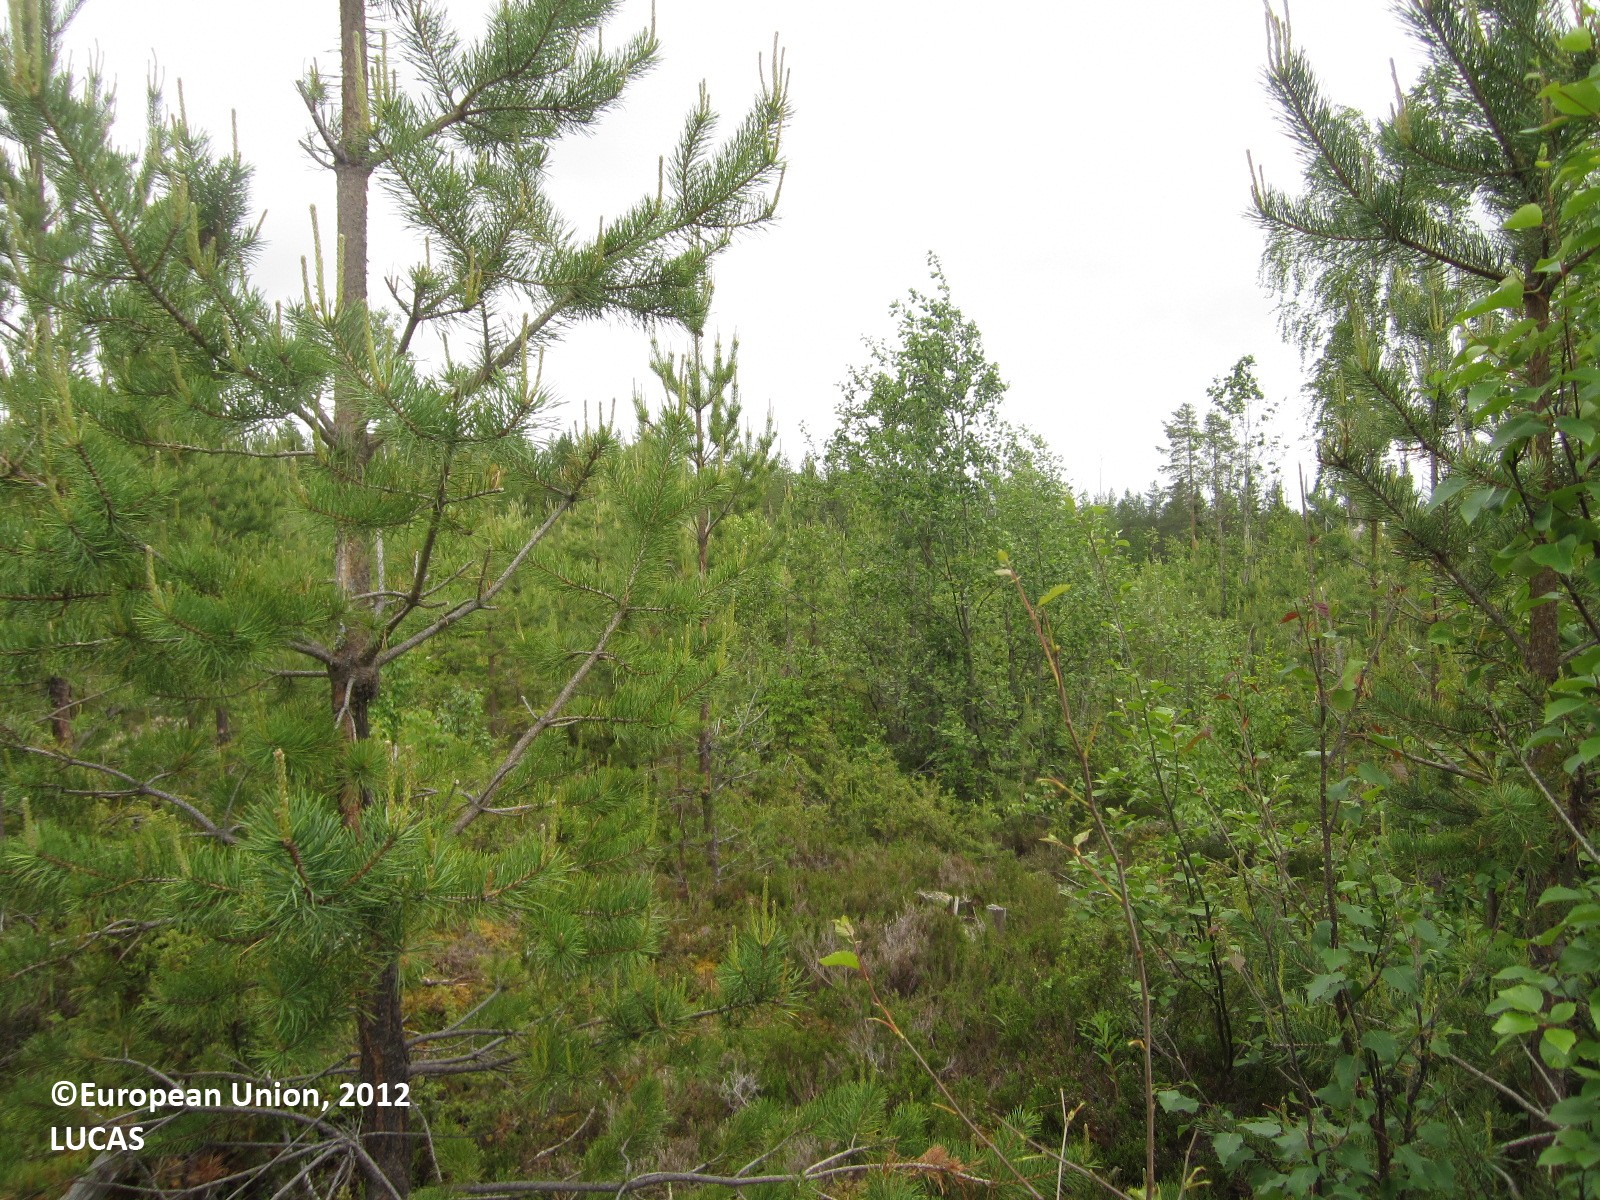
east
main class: Woodland
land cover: Pine dominated mixed woodland
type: boreal forest
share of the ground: 50 - 75 %
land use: Forestry
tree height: < 5 m
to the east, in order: Pine dominated mixed woodland; Rocks and stones; Lichens and moss; Pine dominated mixed woodland; Ditches and canals; Pine dominated mixed woodland; Ditches and canals; Pine dominated mixed woodland; Rocks and stones; Pine dominated mixed woodland; Ditches and canals; Pine dominated mixed woodland
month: June
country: FI
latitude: 64.3570
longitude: 29.5830
